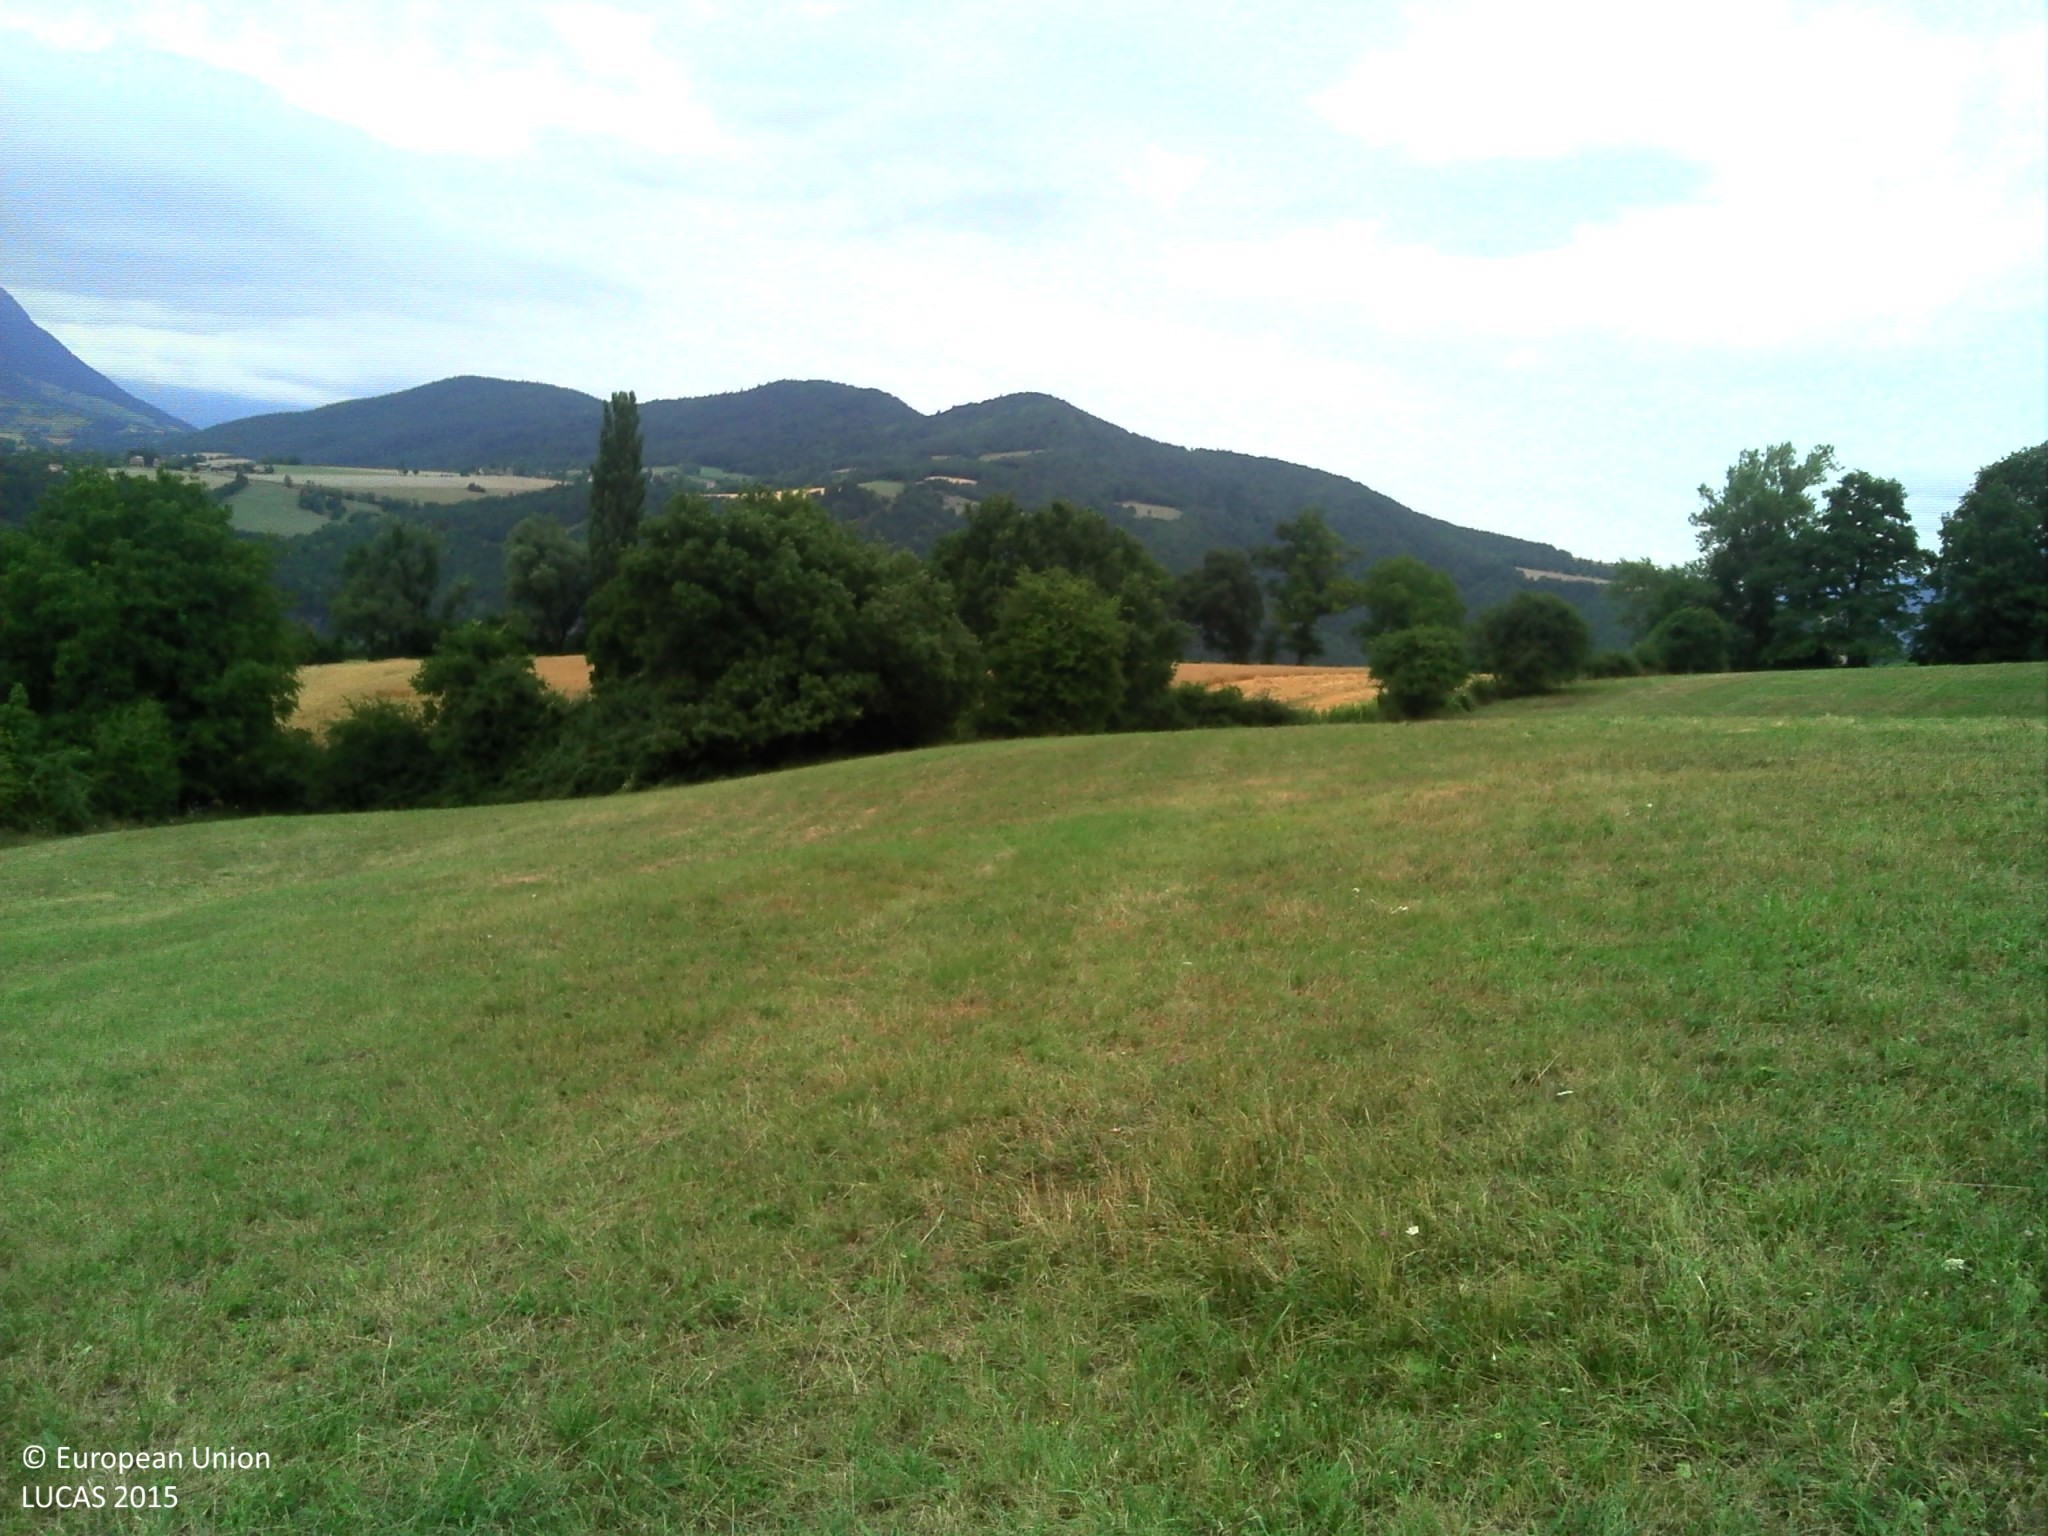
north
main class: Grassland
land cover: Grassland without tree/shrub cover
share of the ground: > 75 %
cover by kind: herbaceous plants 100 %
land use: Agriculture (excluding fallow land and kitchen gardens)
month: July
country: FR
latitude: 44.8559
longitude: 5.6657
